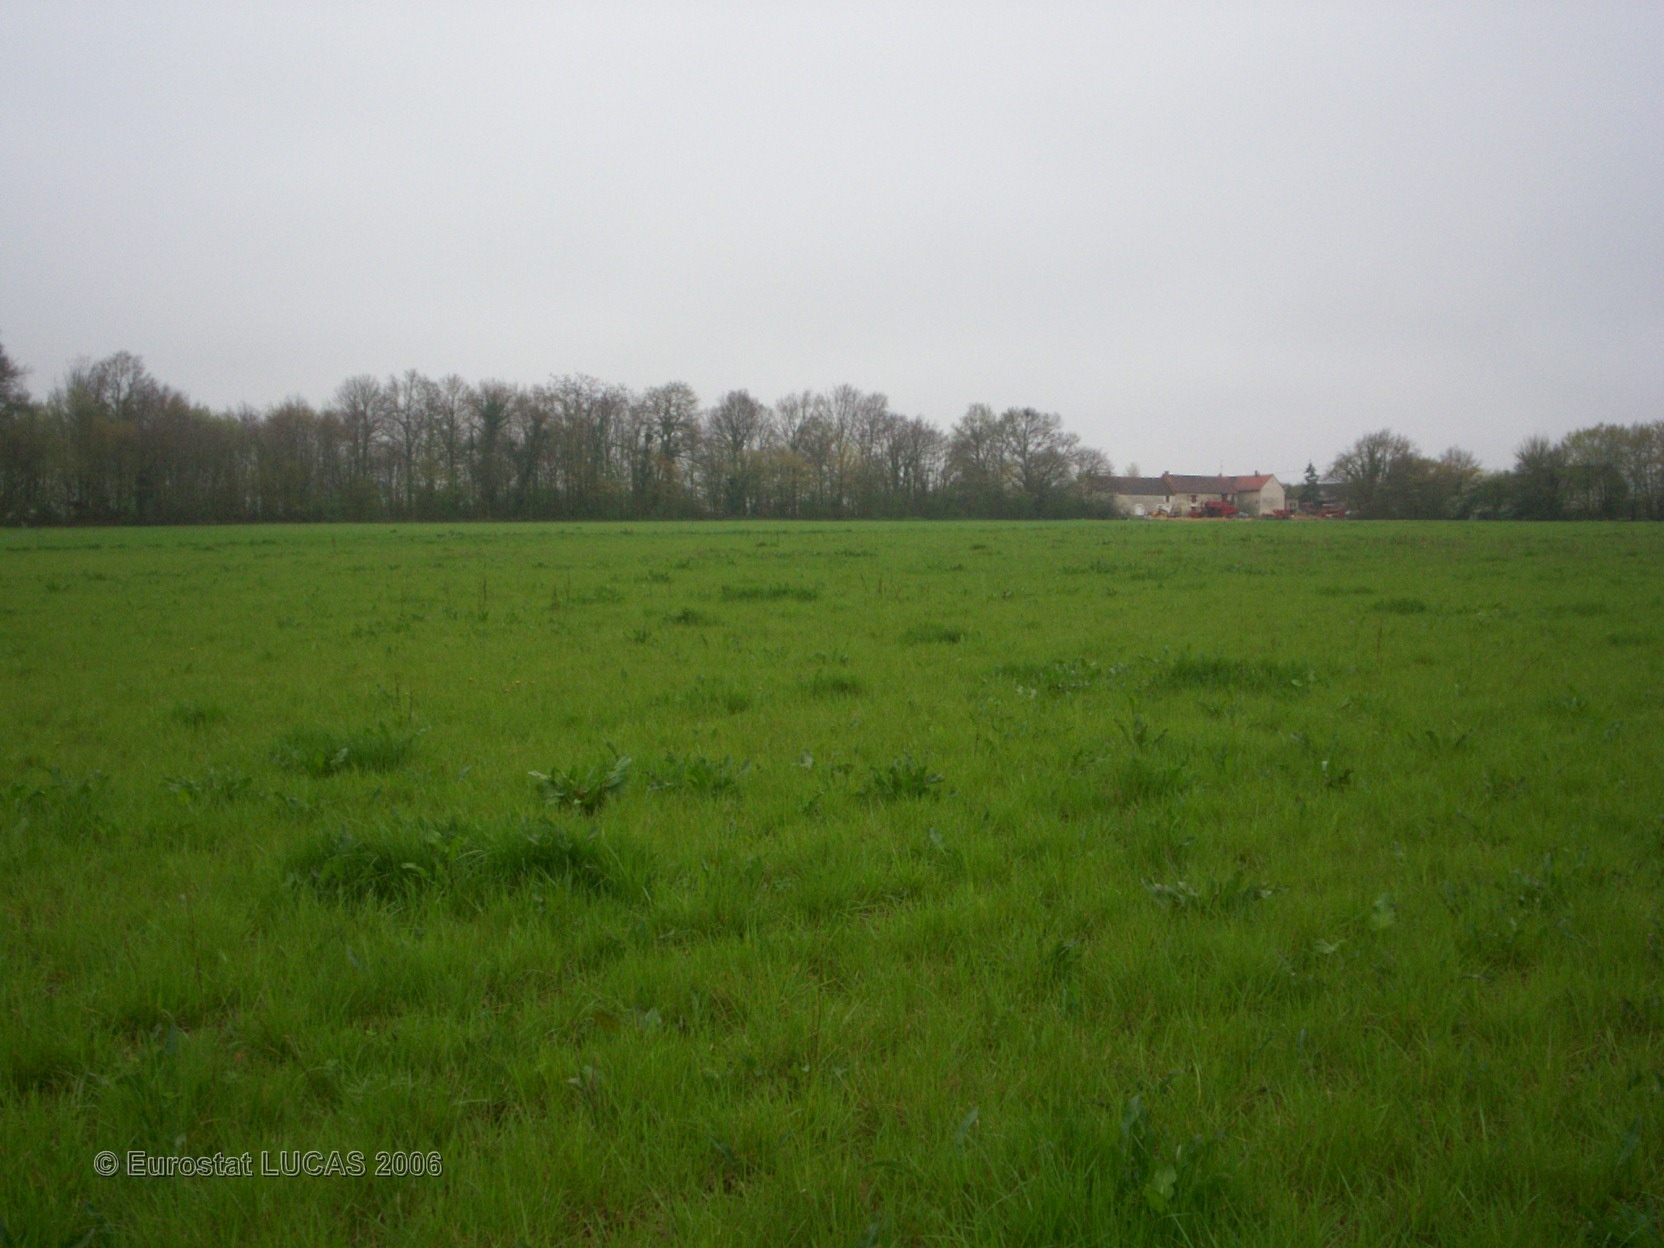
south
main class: Grassland
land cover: Grassland without tree/shrub cover
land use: Agriculture (excluding fallow land and kitchen gardens)
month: April
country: FR
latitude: 47.5275
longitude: 2.9411
